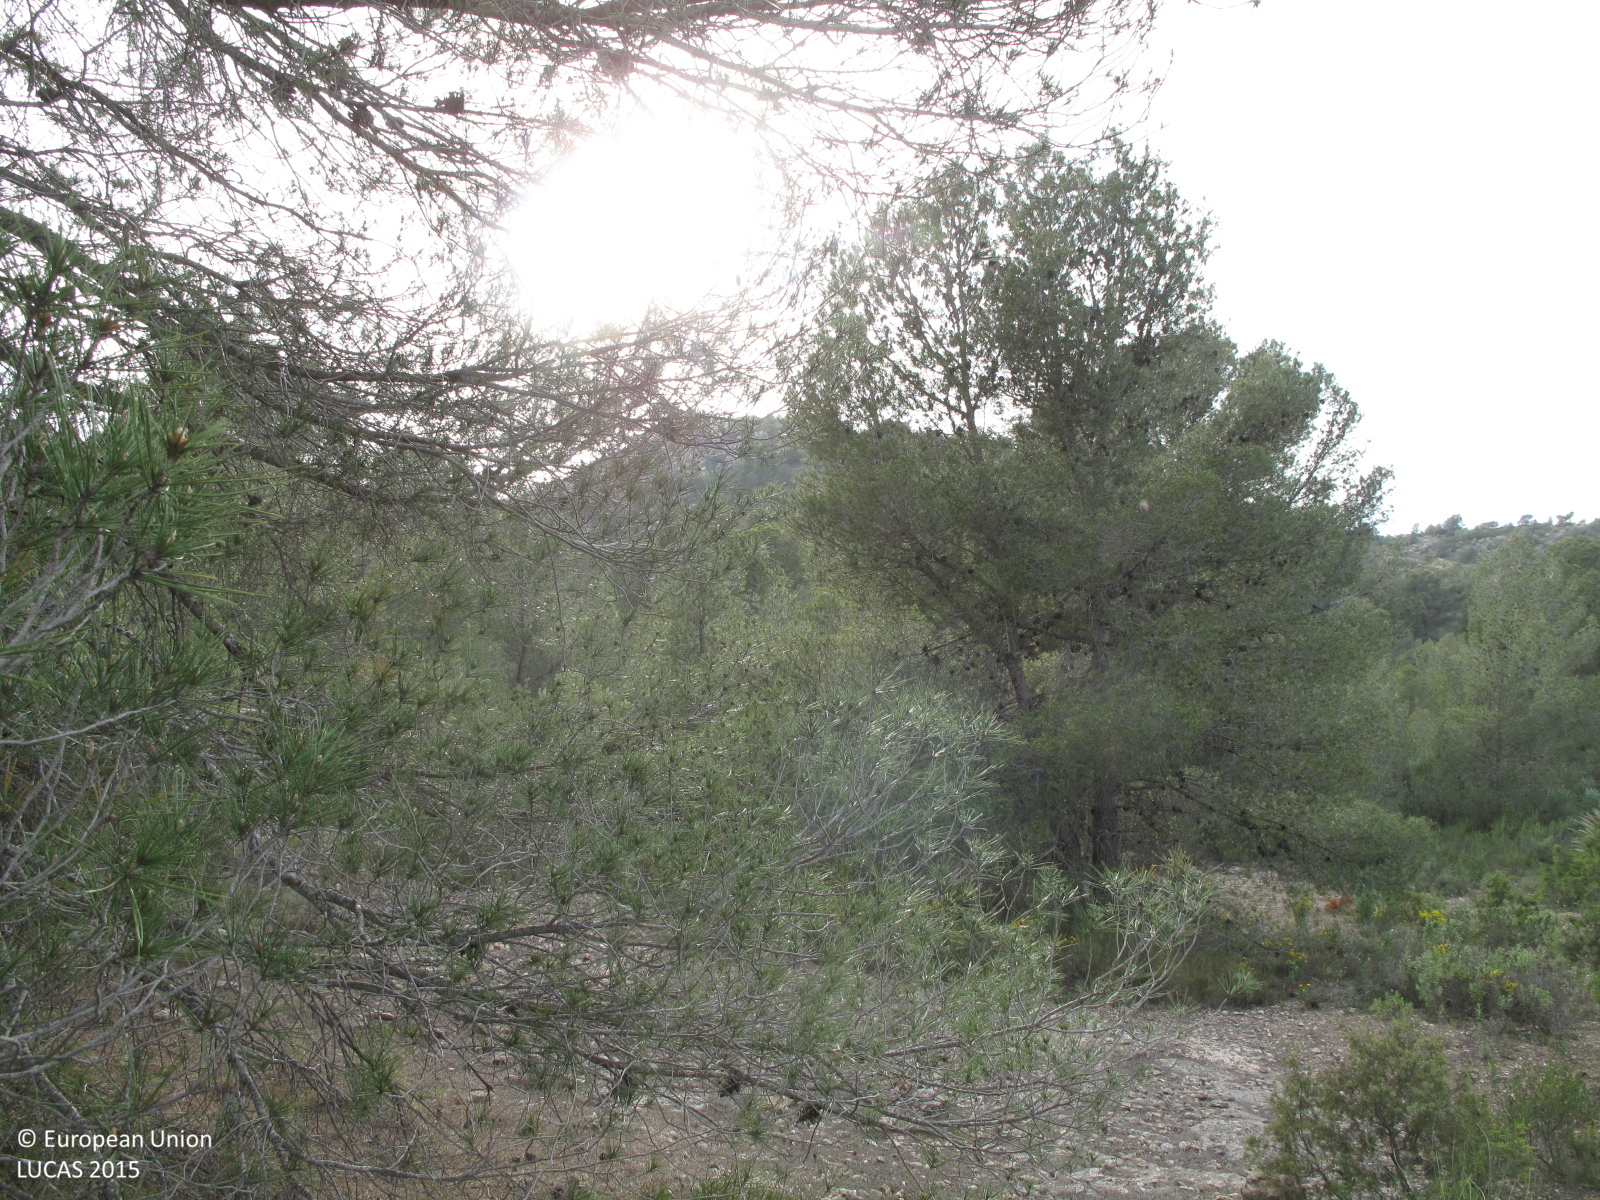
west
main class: Woodland
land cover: Pine dominated coniferous woodland
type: coniferous forest of the mediterranean region
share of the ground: 50 - 75 %
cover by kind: coniferous forest trees 50 %, consolidated bare surface 30 %, shrubs 10 %, herbaceous plants 10 %
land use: Semi-natural and natural areas not in use
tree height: > 5 m
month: April
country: ES
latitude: 38.4190
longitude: -0.8802
